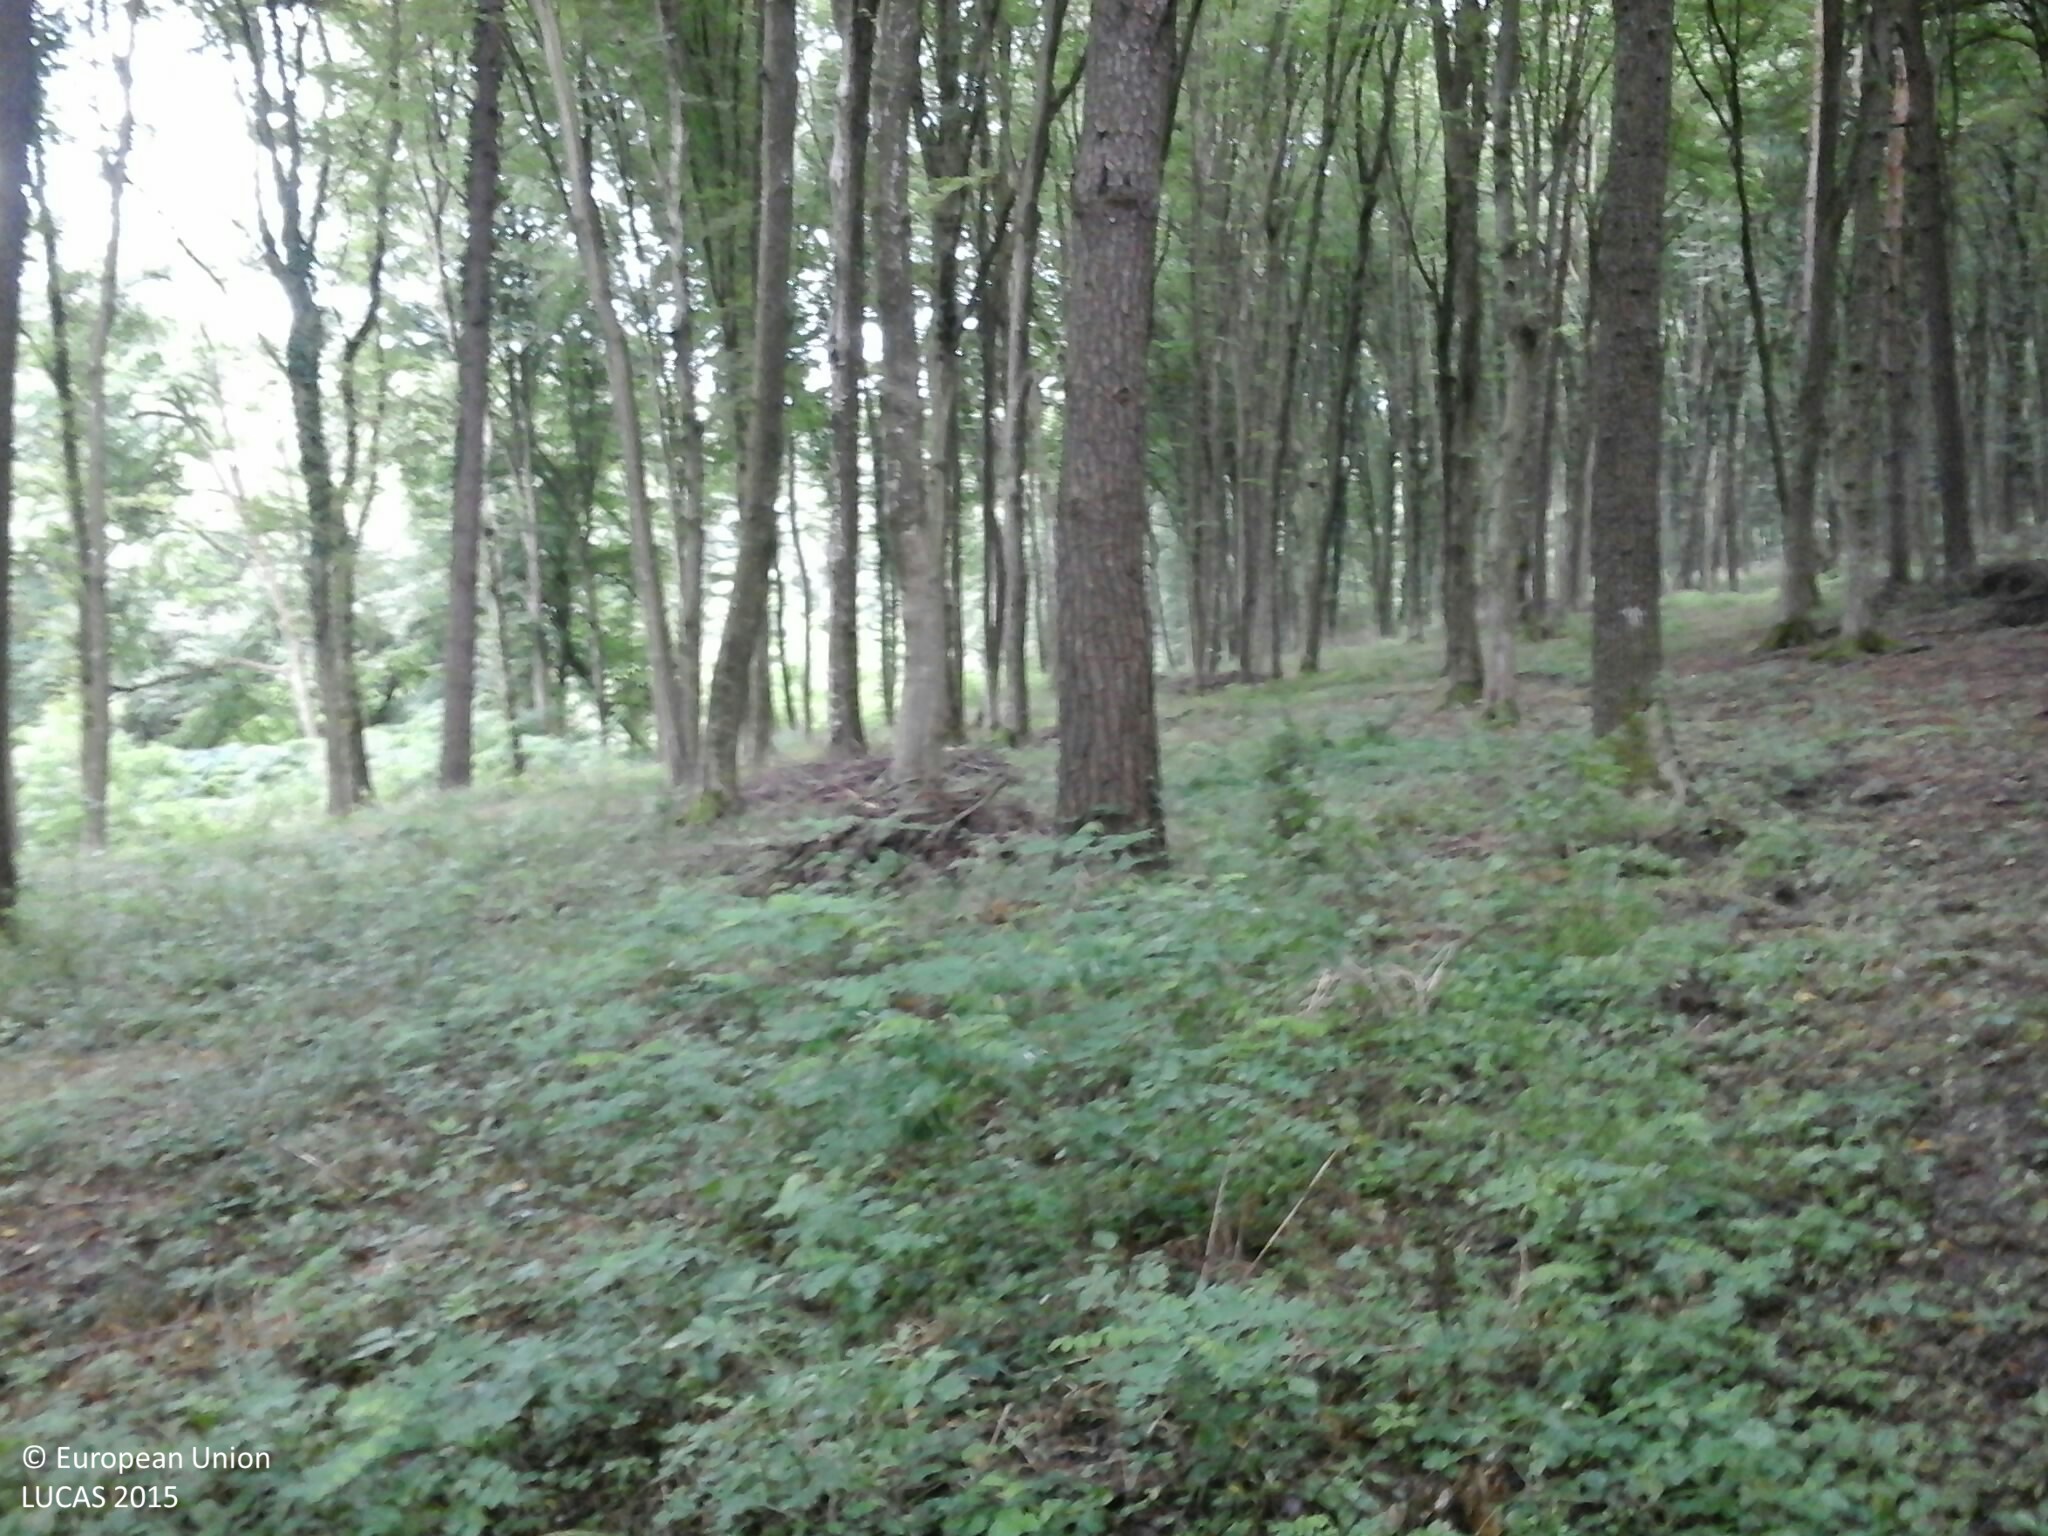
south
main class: Woodland
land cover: Broadleaved woodland
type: beech forest
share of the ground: 50 - 75 %
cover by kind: broadleaved forest trees 65 %, shrubs 25 %, herbaceous plants 10 %
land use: Forestry
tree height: > 5 m
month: July
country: HU
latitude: 46.8356
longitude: 16.5709
